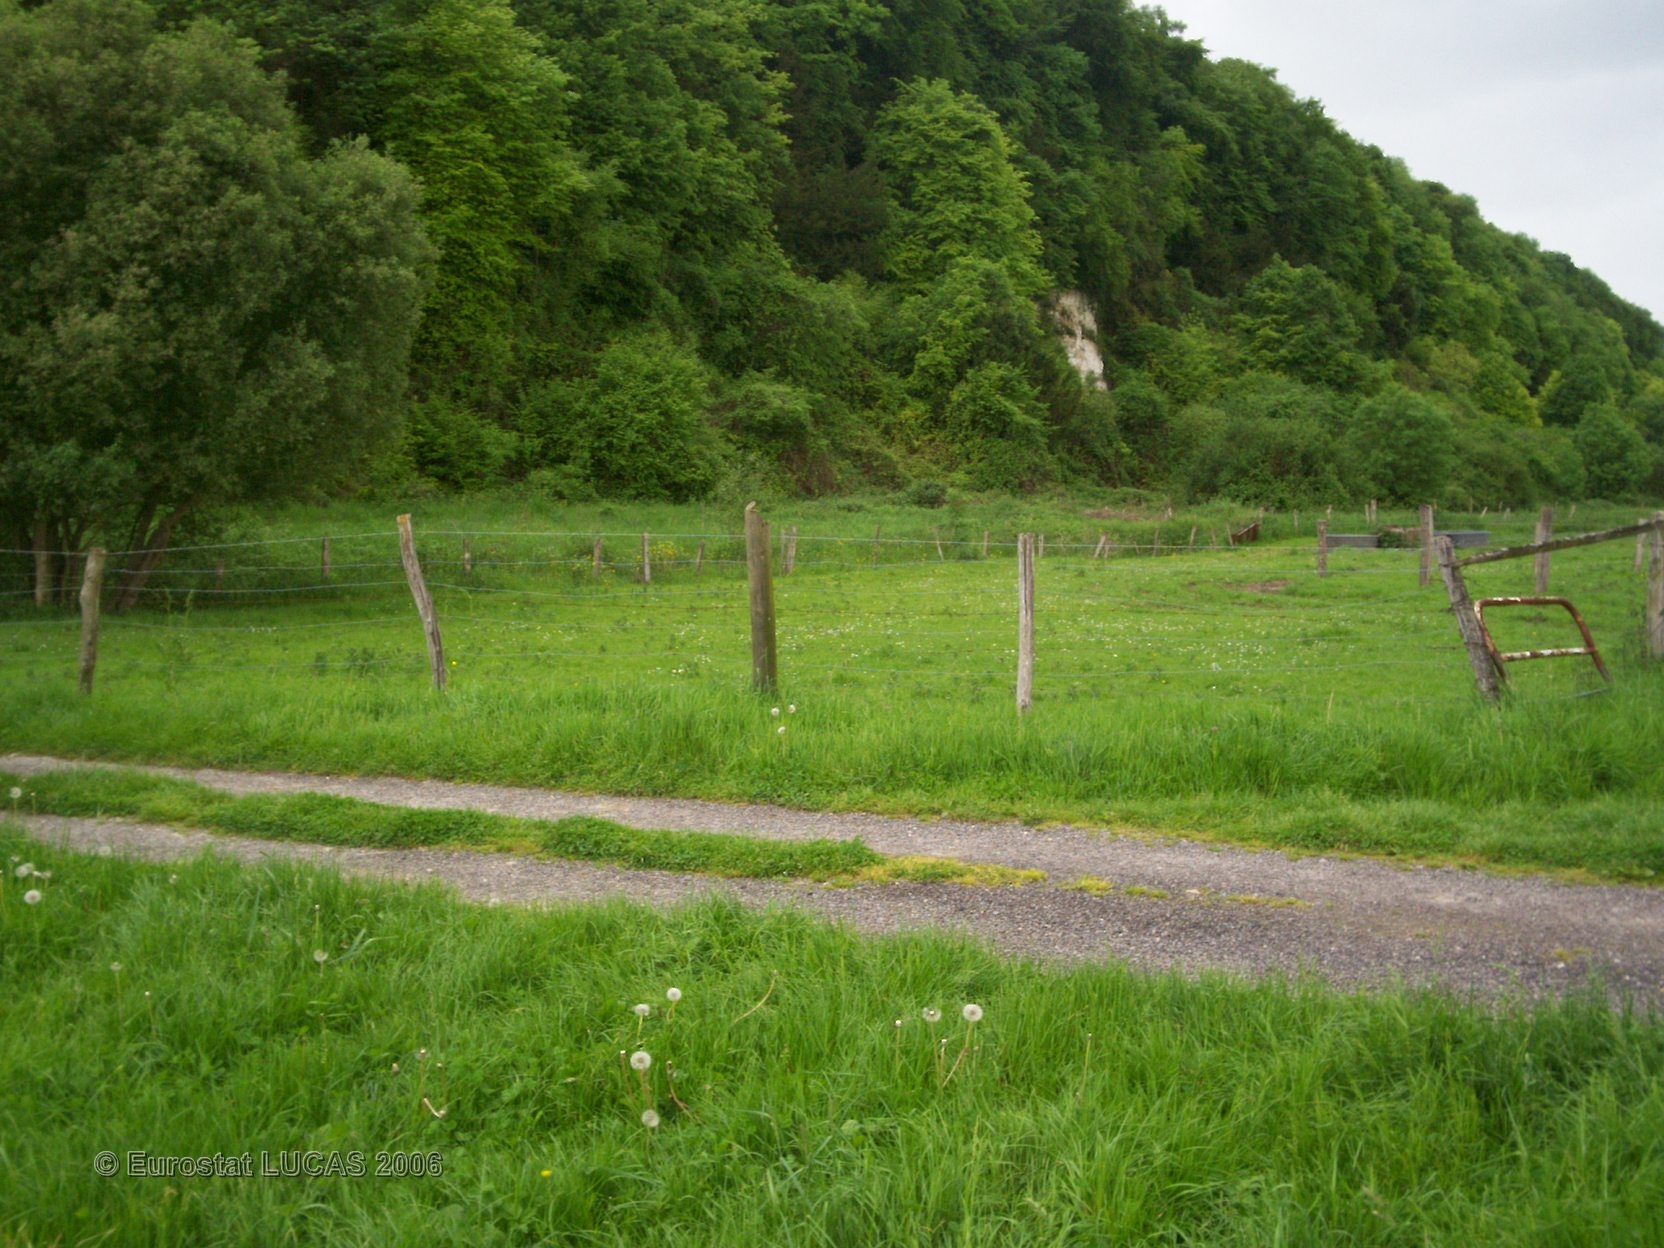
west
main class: Grassland
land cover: Grassland without tree/shrub cover
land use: Agriculture (excluding fallow land and kitchen gardens)
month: May
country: FR
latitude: 49.4379
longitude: 0.4437
